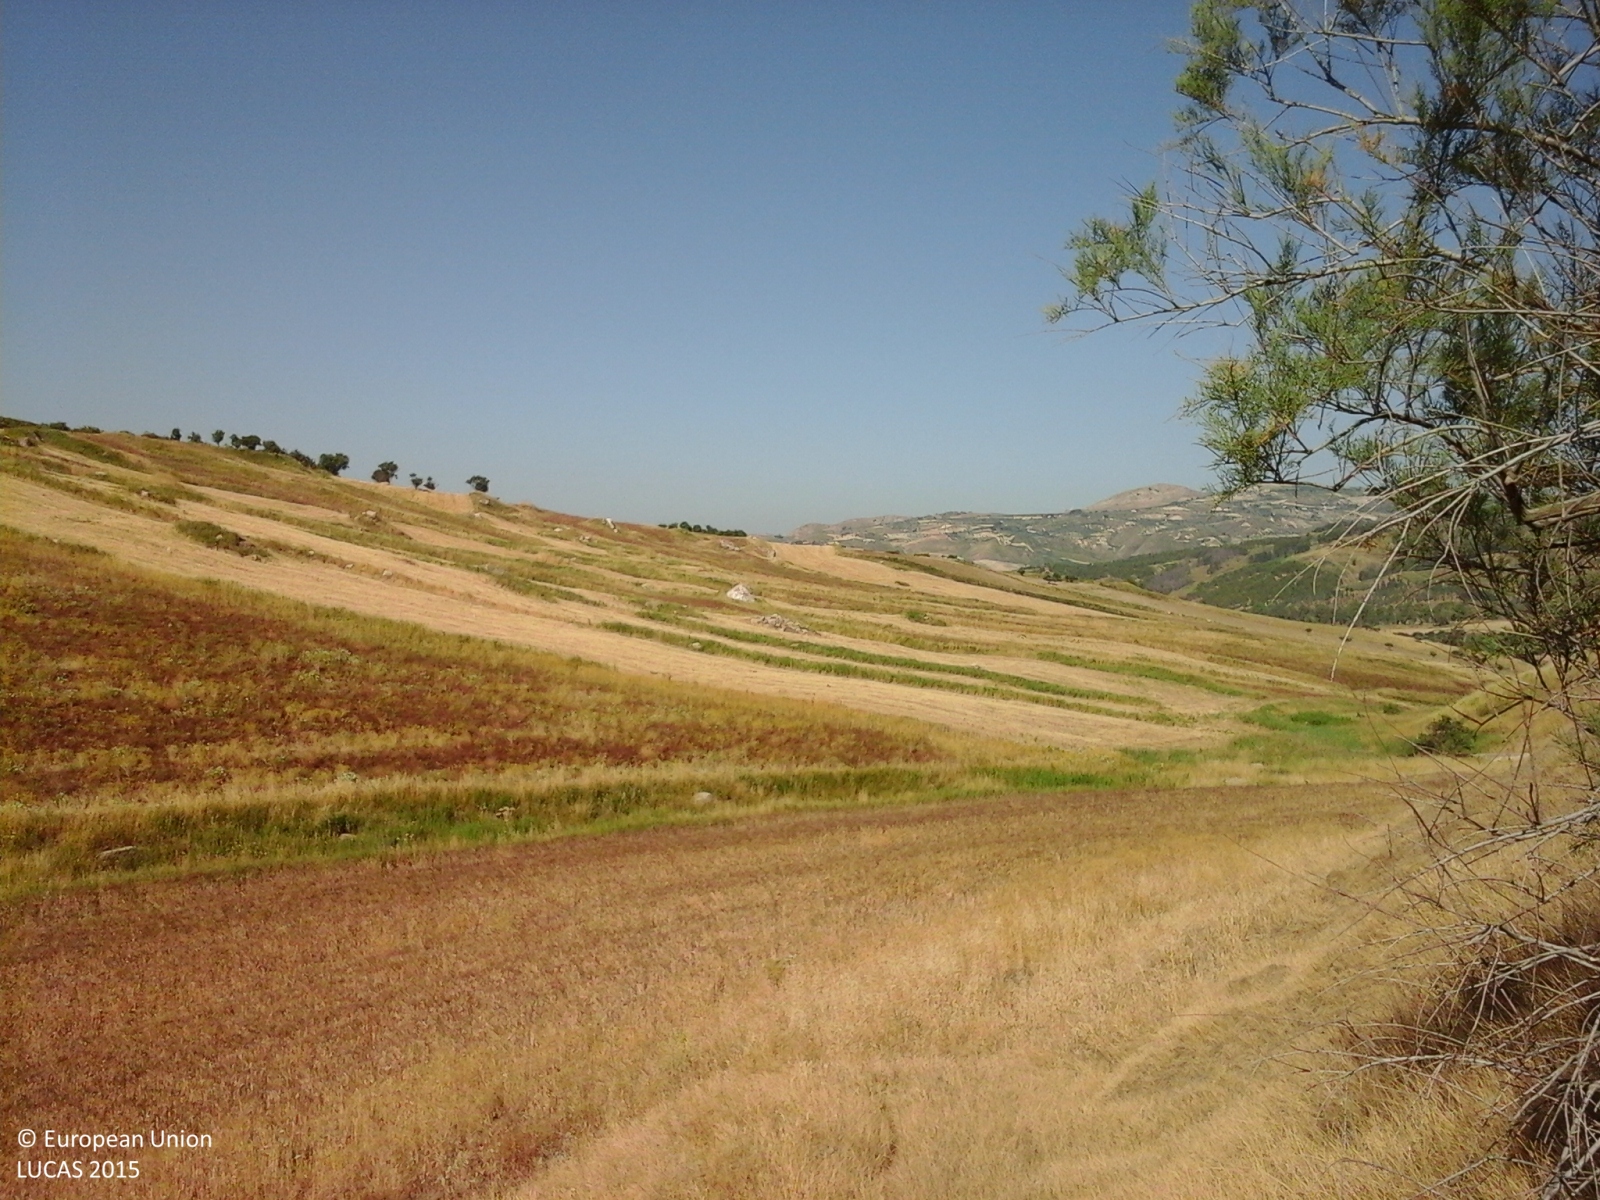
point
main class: Cropland
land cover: Durum wheat
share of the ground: > 75 %
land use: Agriculture (excluding fallow land and kitchen gardens)
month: July
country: IT
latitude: 37.5545
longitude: 13.5390
